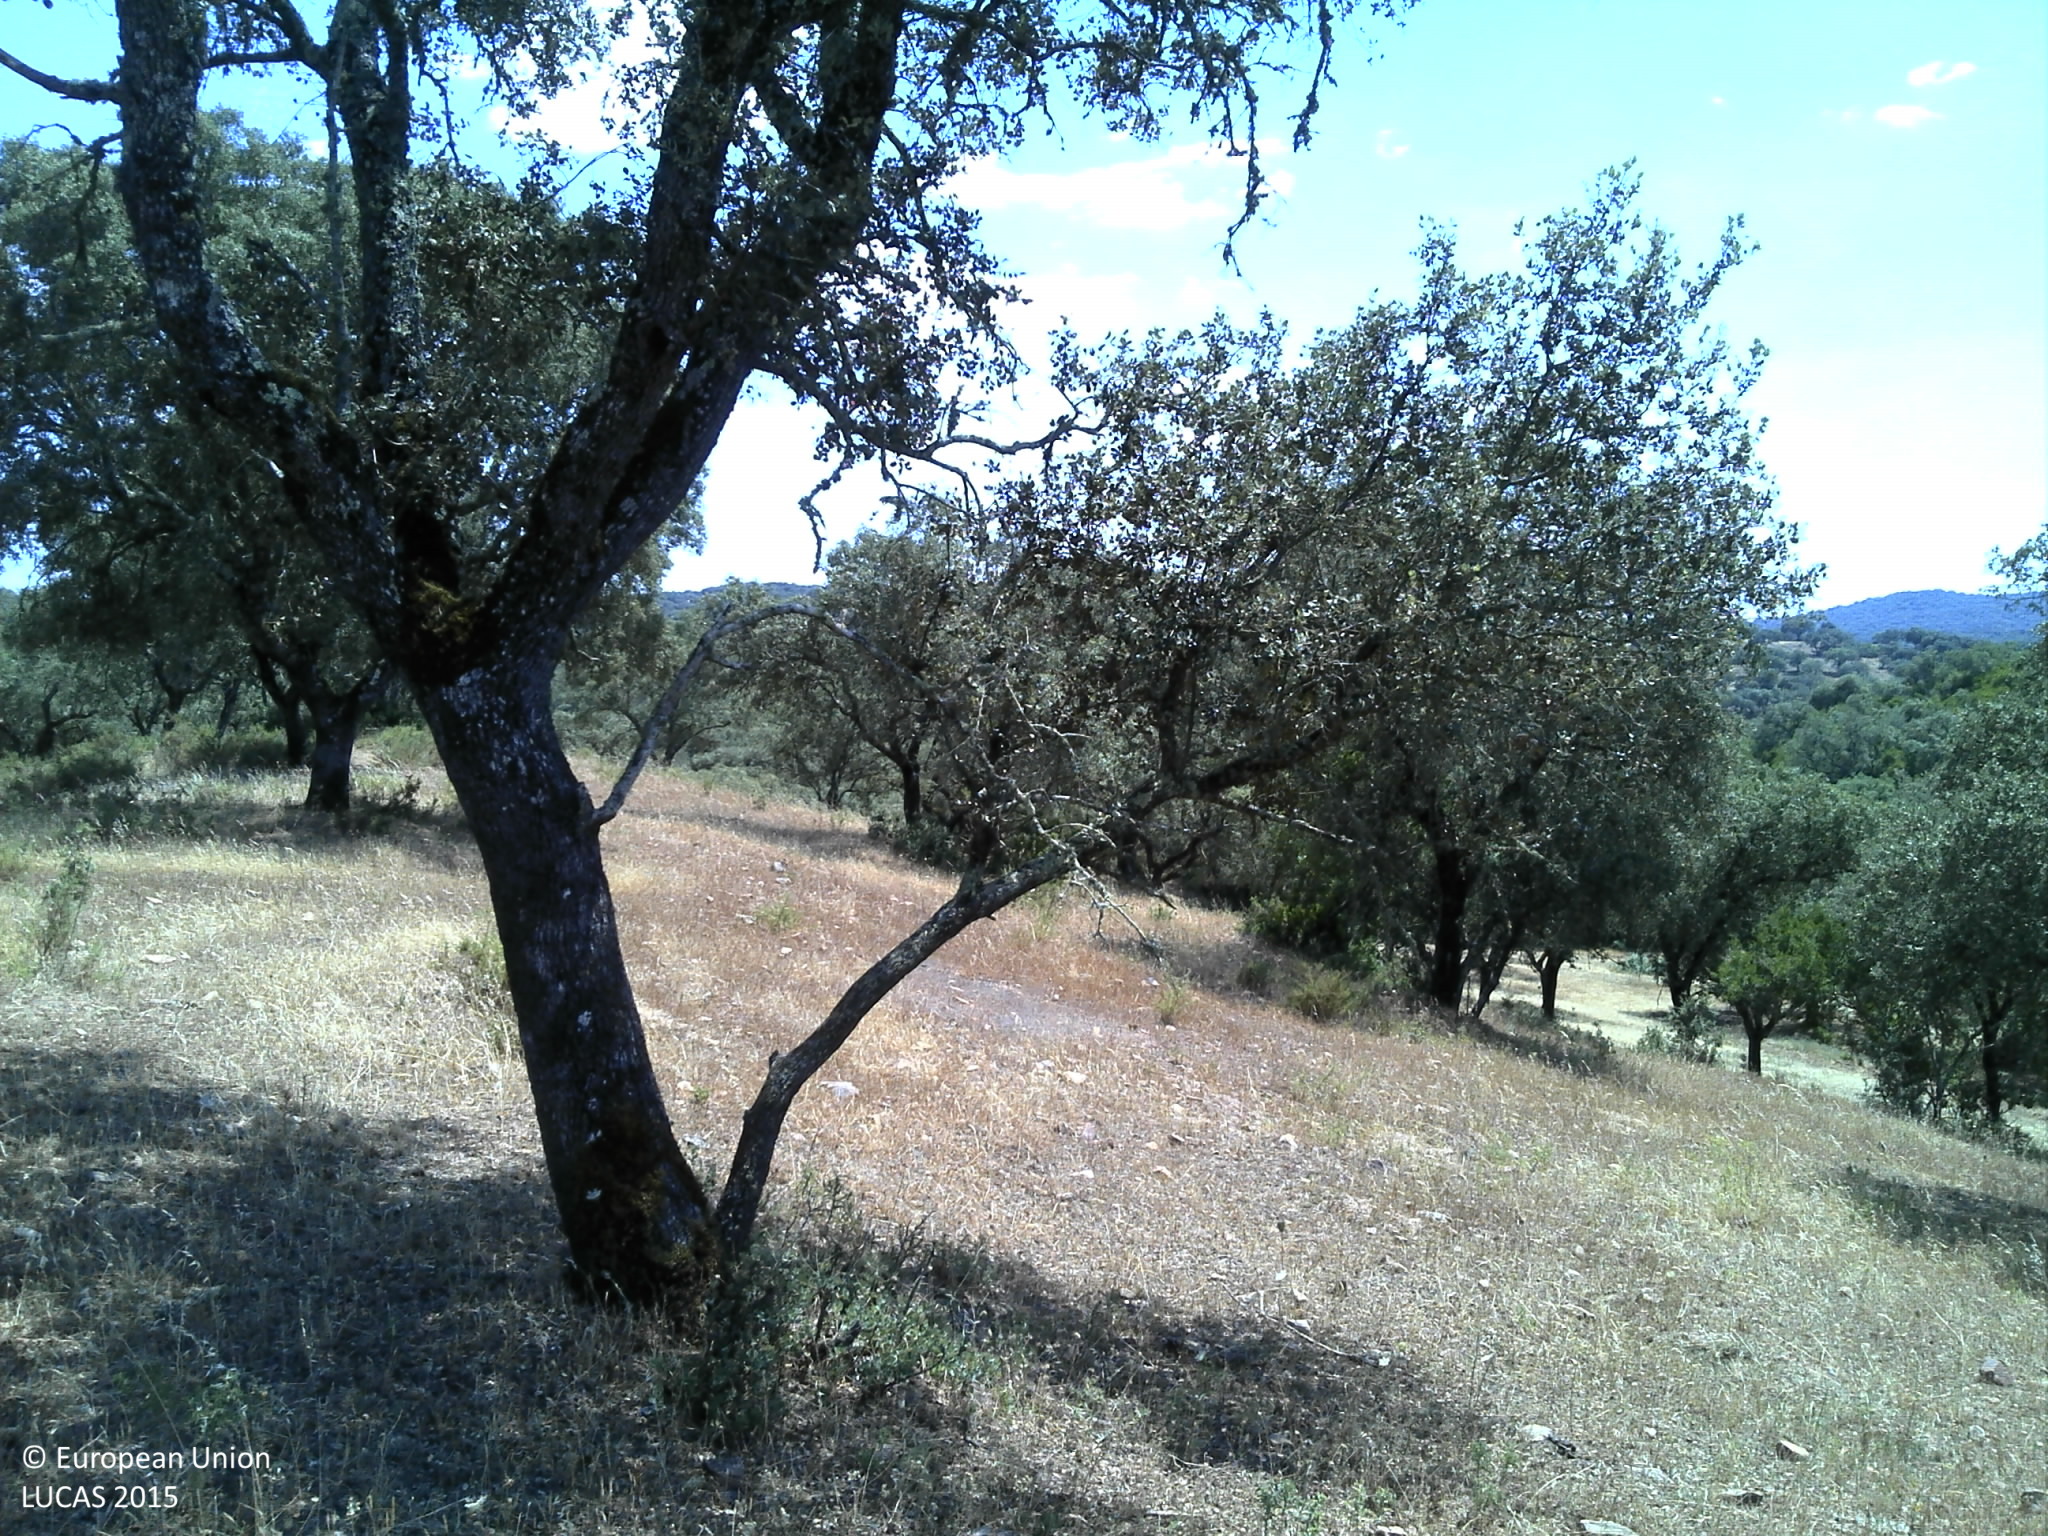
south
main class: Woodland
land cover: Broadleaved woodland
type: broadleaved evergreen forest
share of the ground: 25 - 50 %
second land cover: Shrubland without tree cover
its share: 25 - 50 %
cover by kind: shrubs 50 %, broadleaved forest trees 25 %, unconsolidated bare surface 15 %, herbaceous plants 10 %
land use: Forestry
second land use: Agriculture (excluding fallow land and kitchen gardens)
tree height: > 5 m
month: June
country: PT
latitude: 38.4239
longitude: -8.1754
